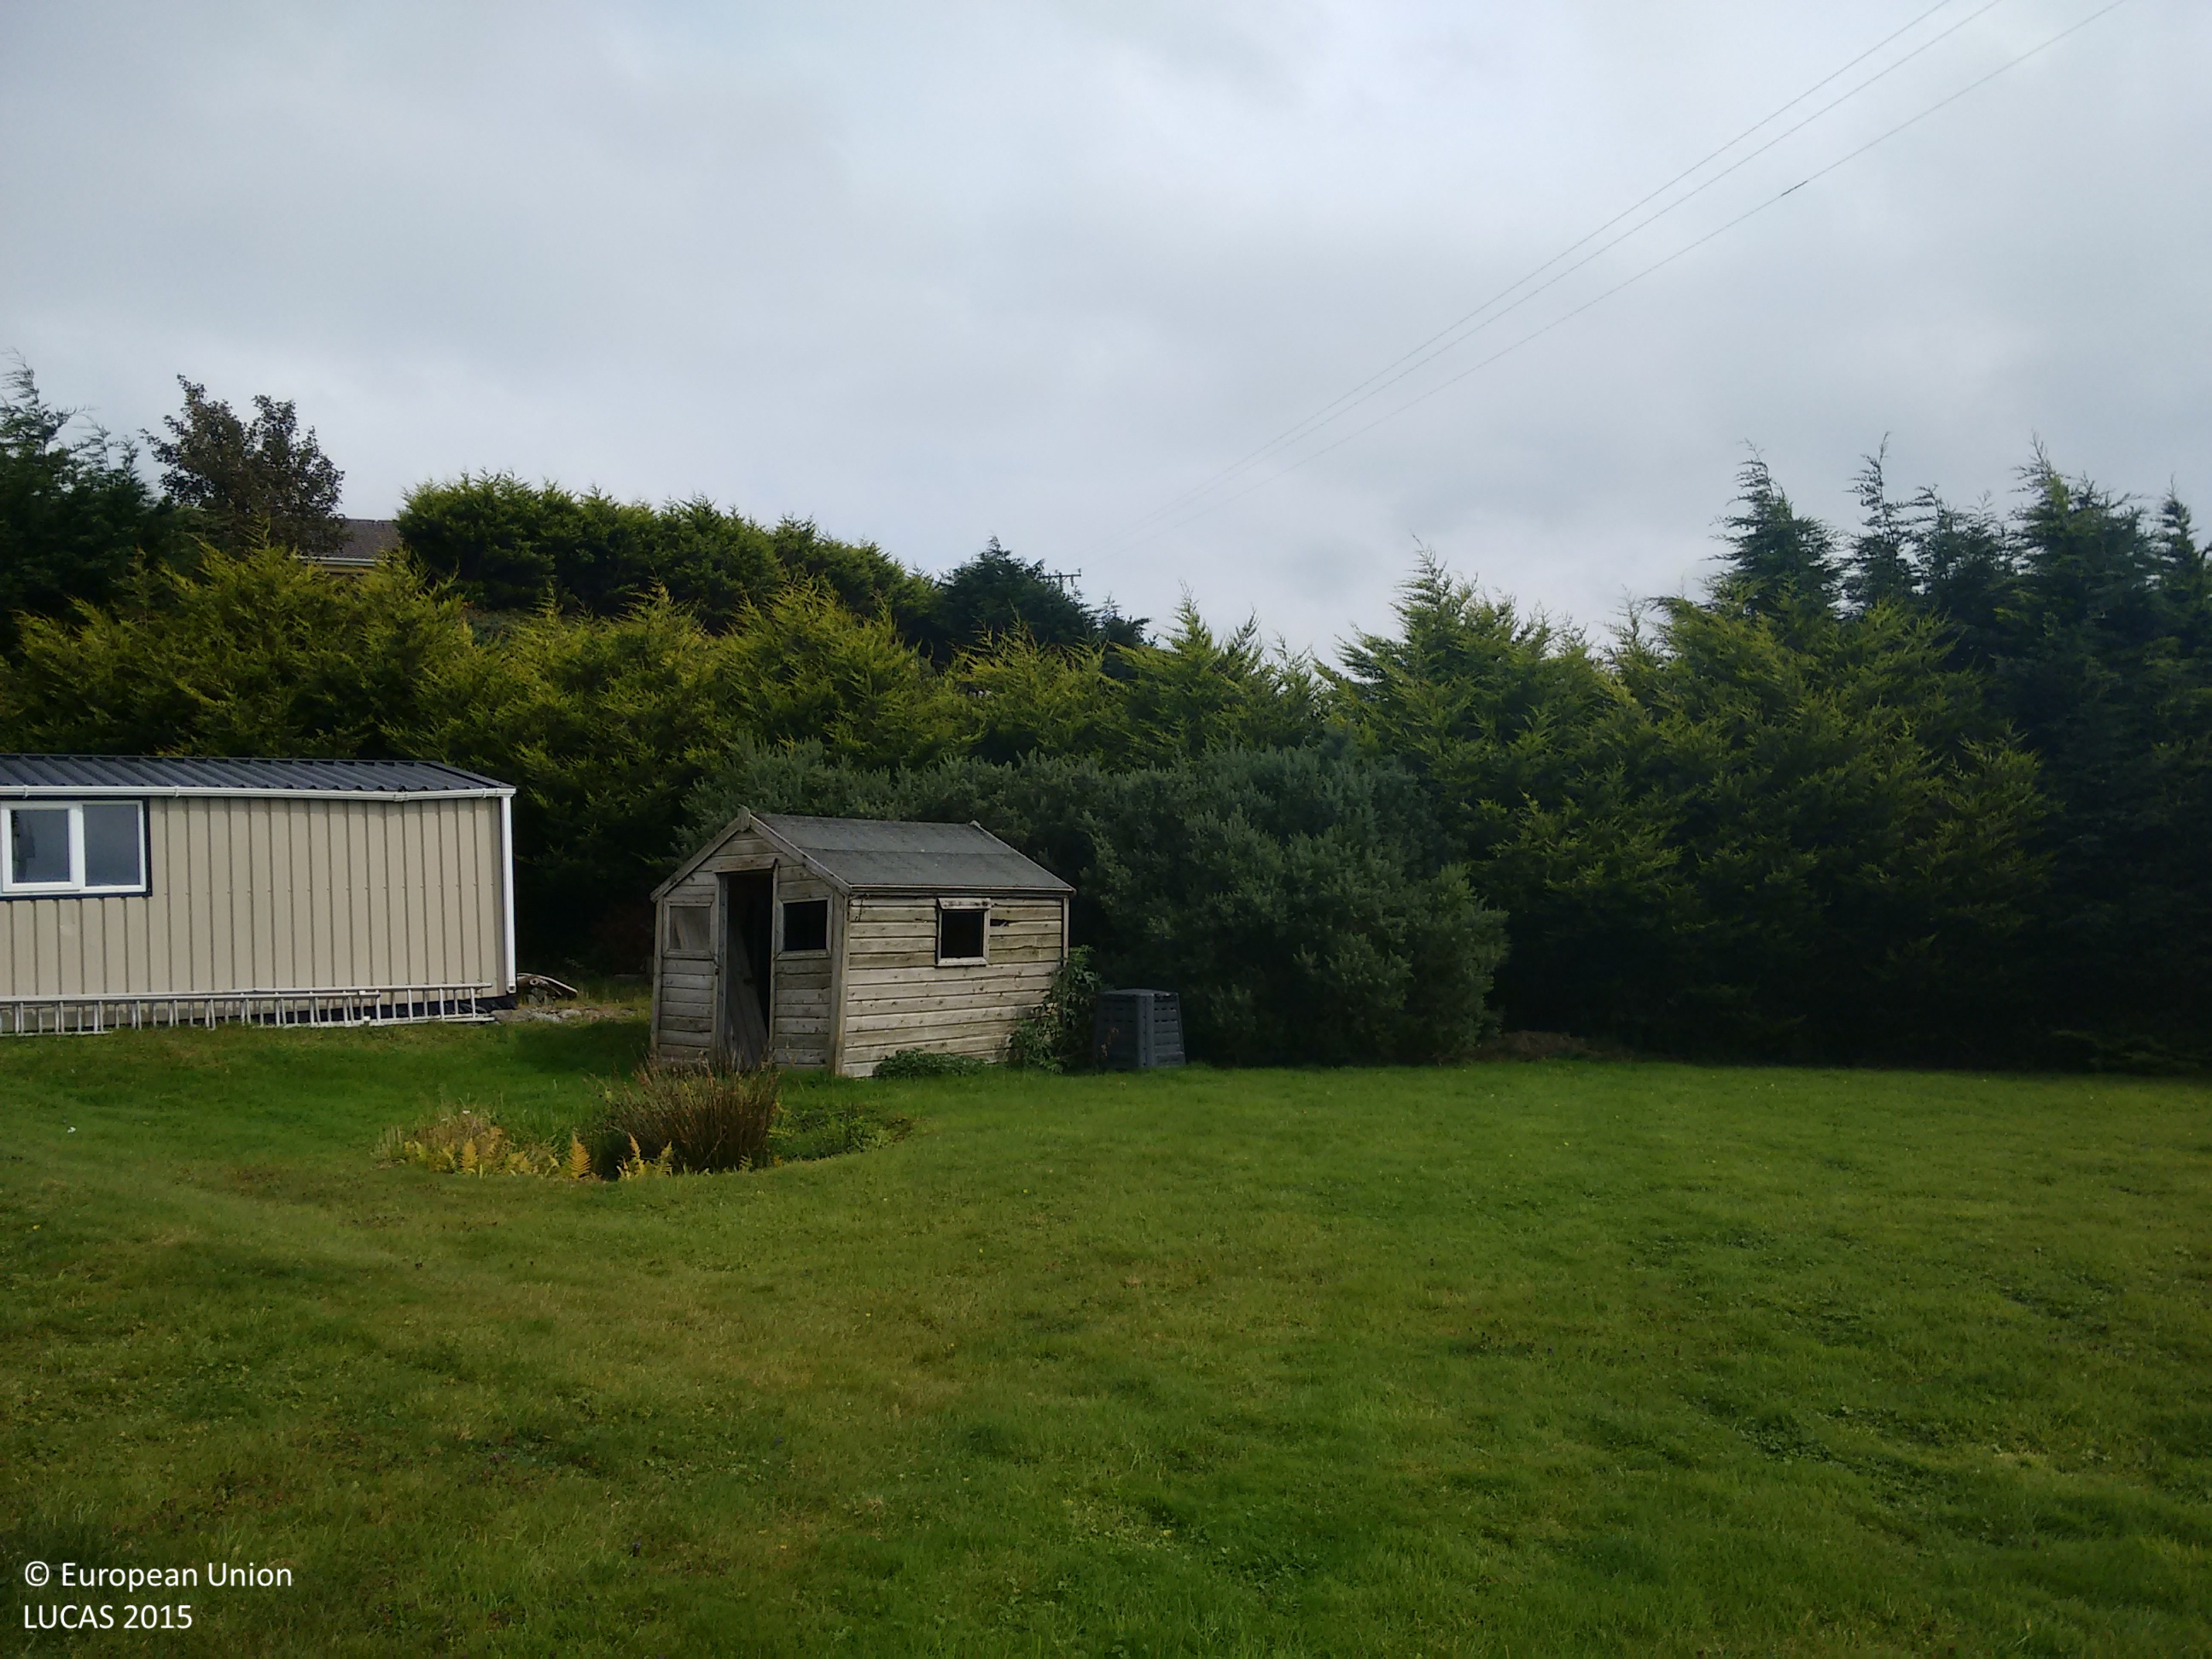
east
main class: Grassland
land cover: Grassland without tree/shrub cover
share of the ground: > 75 %
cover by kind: herbaceous plants 80 %
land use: Residential
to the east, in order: Grassland without tree/shrub cover; Artificial constructions in urban areas; Abandoned hedges; Grassland with sparse tree/shrub cover; Artificial constructions in urban areas; Grassland without tree/shrub cover; Electric lines; Grassland without tree/shrub cover; Fences; Tracks; Fences; Grassland without tree/shrub cover; Fences; Grassland without tree/shrub cover; Fences; Grassland without tree/shrub cover; Abandoned hedges
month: September
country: IE
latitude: 52.0621
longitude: -9.4404
